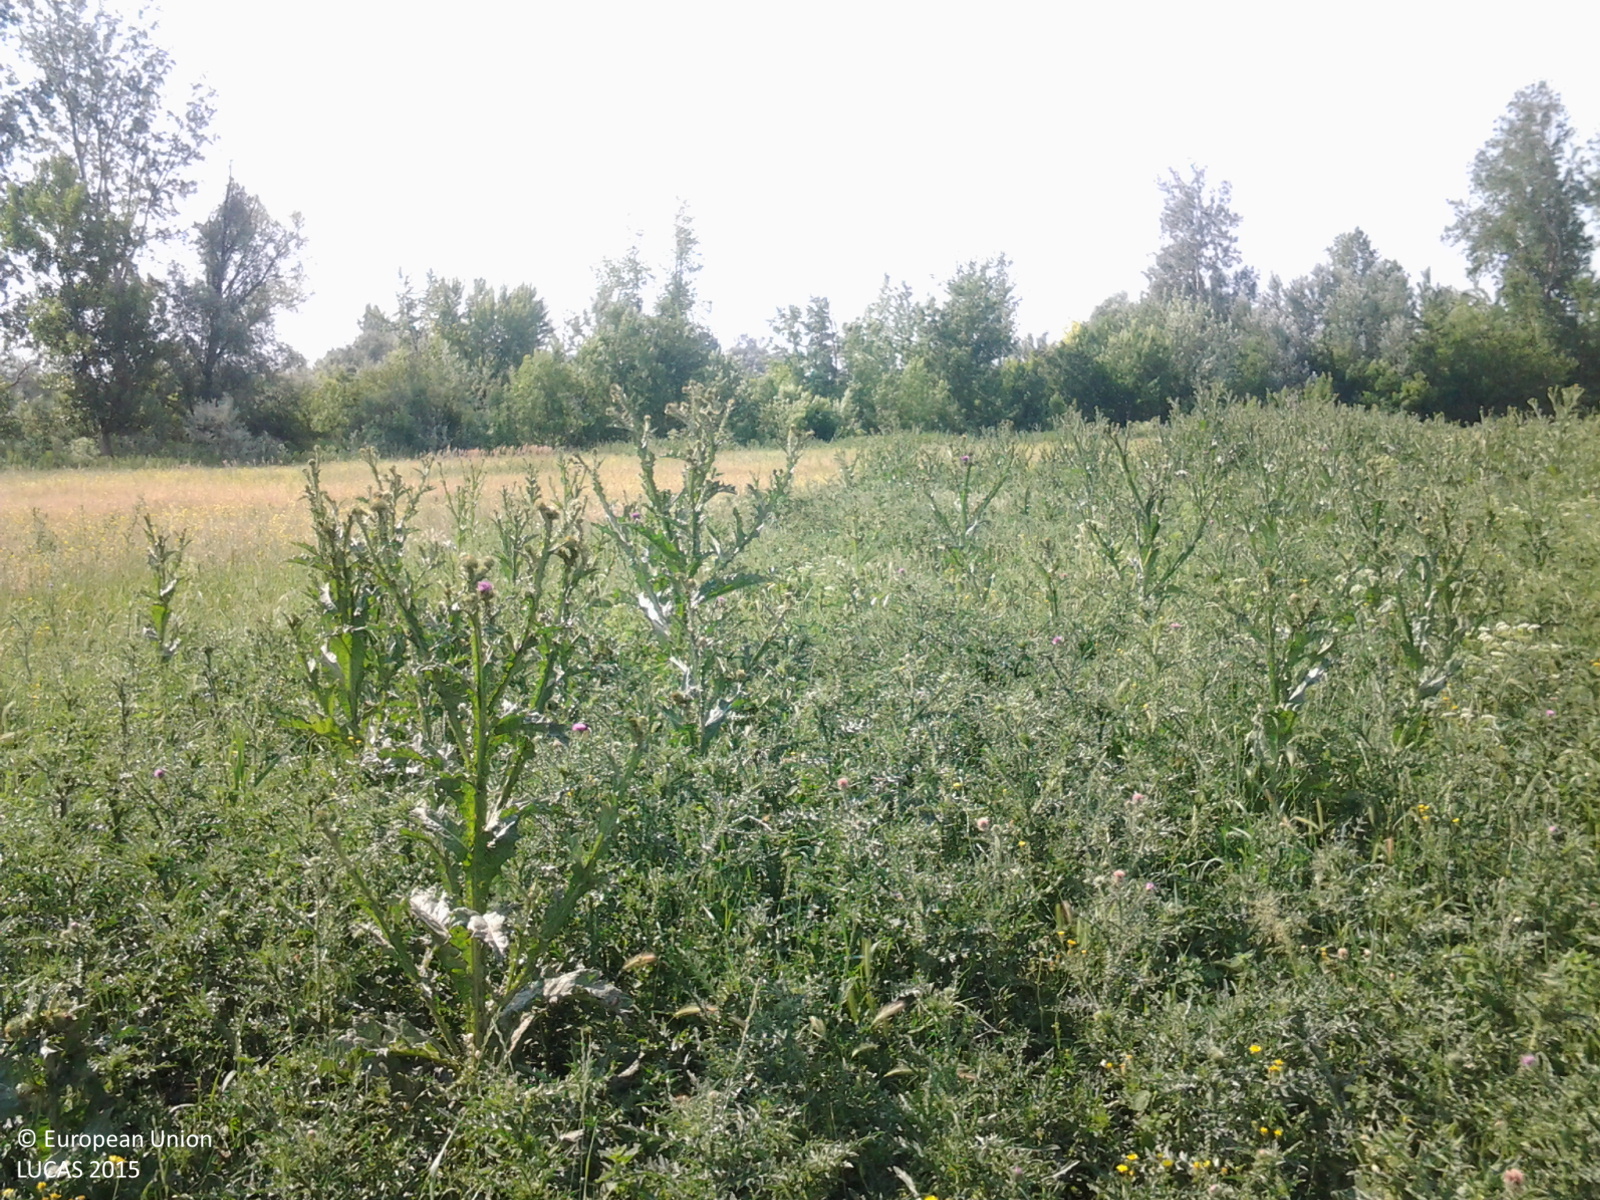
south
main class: Woodland
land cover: Broadleaved woodland
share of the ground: 10 - 25 %
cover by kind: herbaceous plants 75 %, broadleaved forest trees 15 %, shrubs 10 %
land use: Semi-natural and natural areas not in use
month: June
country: HU
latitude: 46.5552
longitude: 18.9483
